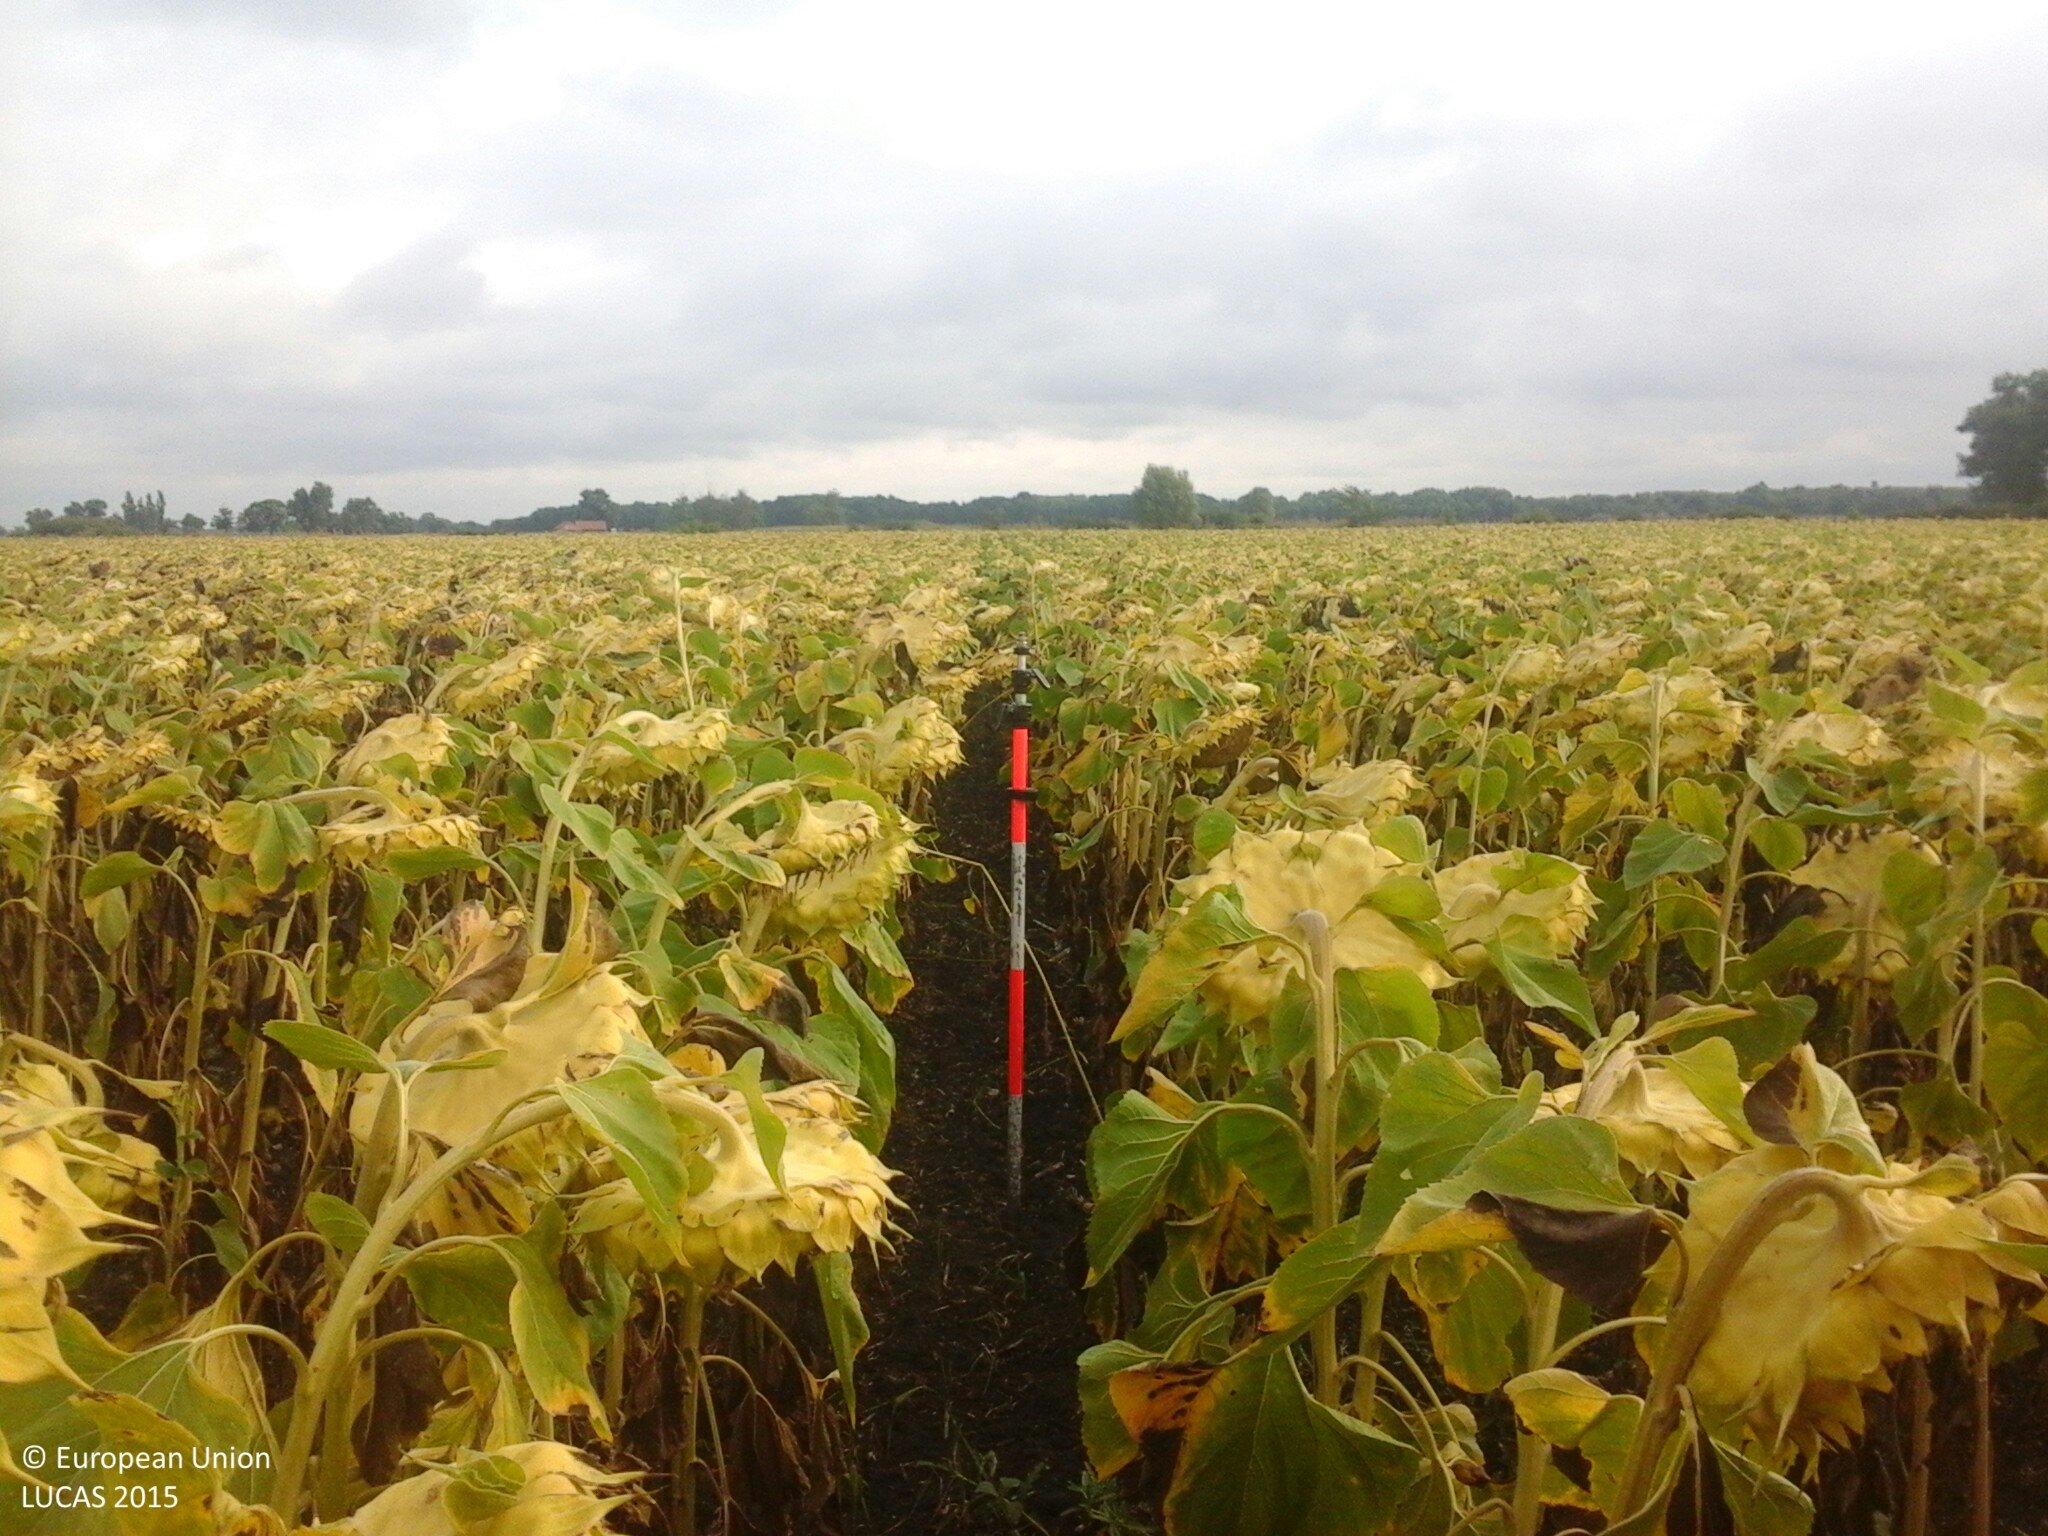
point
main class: Cropland
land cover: Sunflower
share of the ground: > 75 %
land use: Agriculture (excluding fallow land and kitchen gardens)
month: August
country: HU
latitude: 47.0618
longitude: 21.6153
